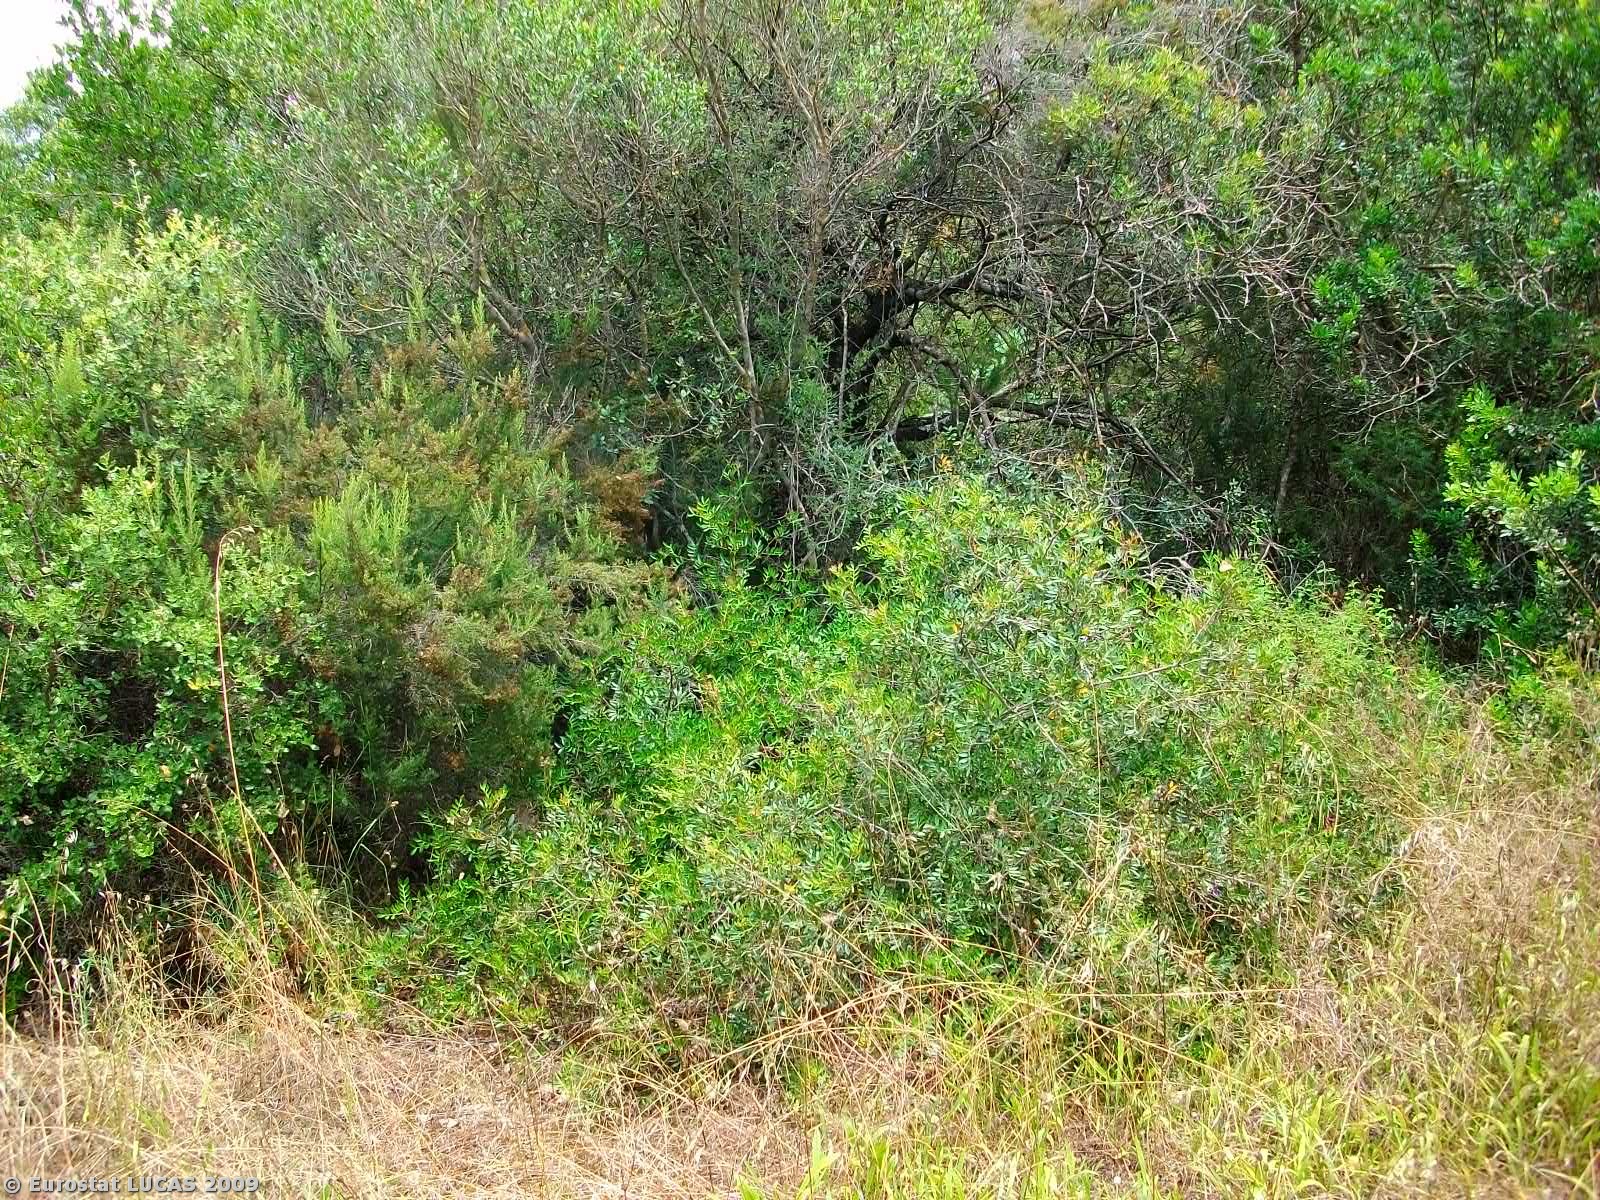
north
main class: Woodland
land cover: Broadleaved woodland
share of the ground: > 75 %
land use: Forestry
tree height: < 5 m
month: June
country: GR
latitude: 38.8570
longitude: 21.5084
